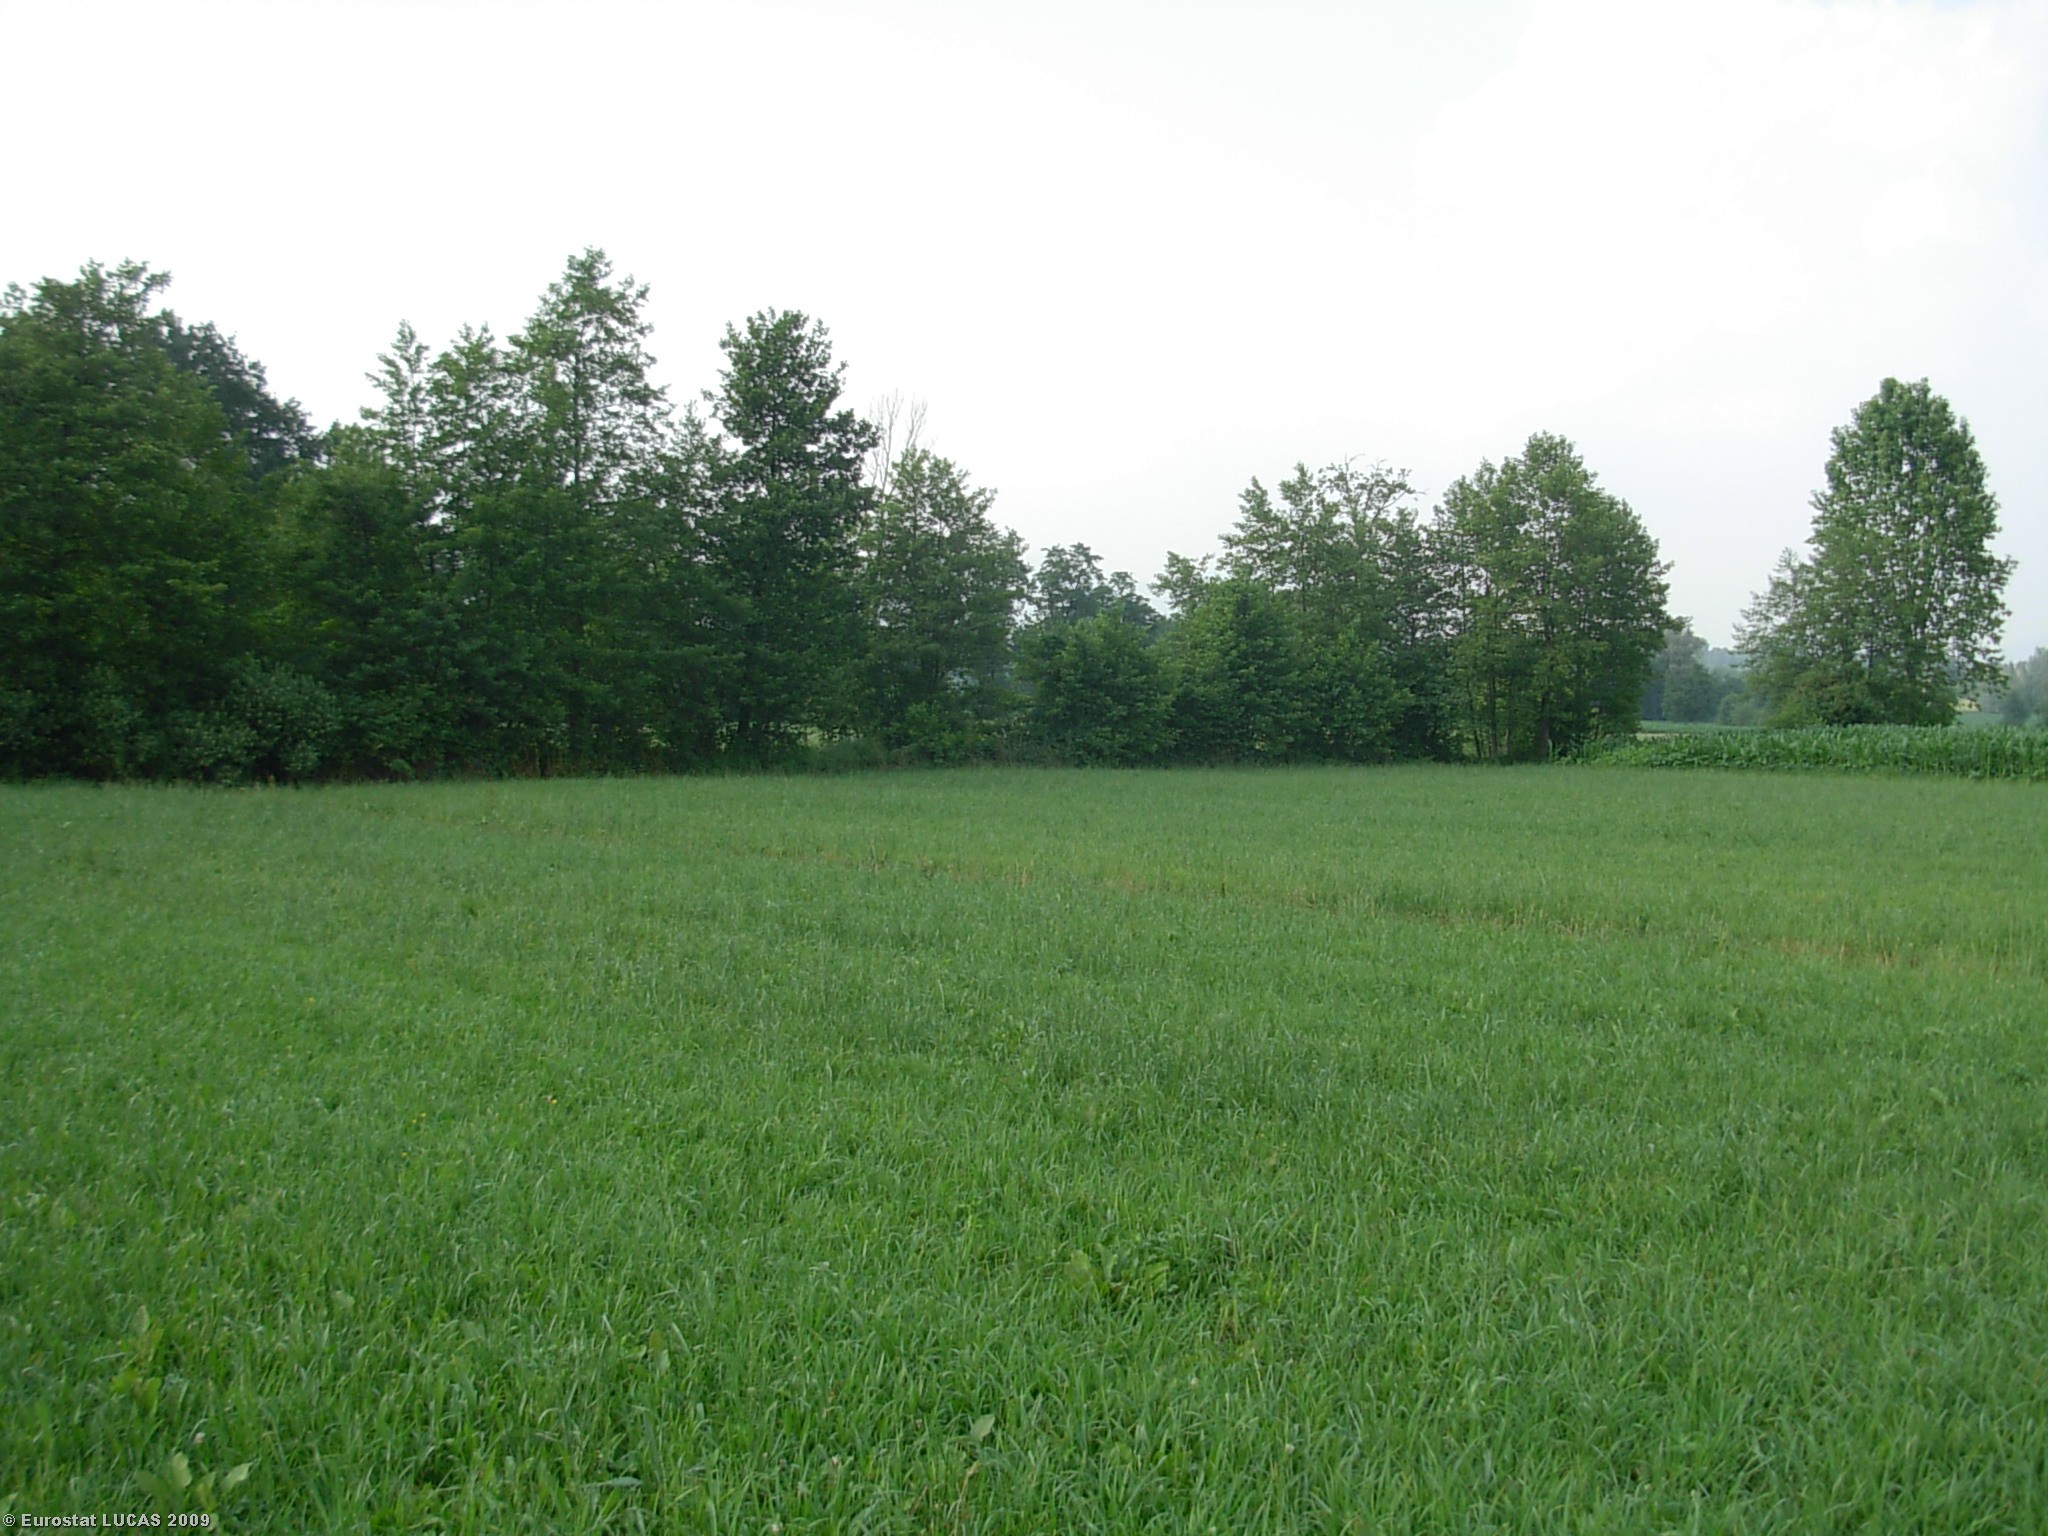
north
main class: Grassland
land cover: Grassland without tree/shrub cover
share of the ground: > 75 %
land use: Agriculture (excluding fallow land and kitchen gardens)
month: June
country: IT
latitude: 45.7183
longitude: 9.2945
